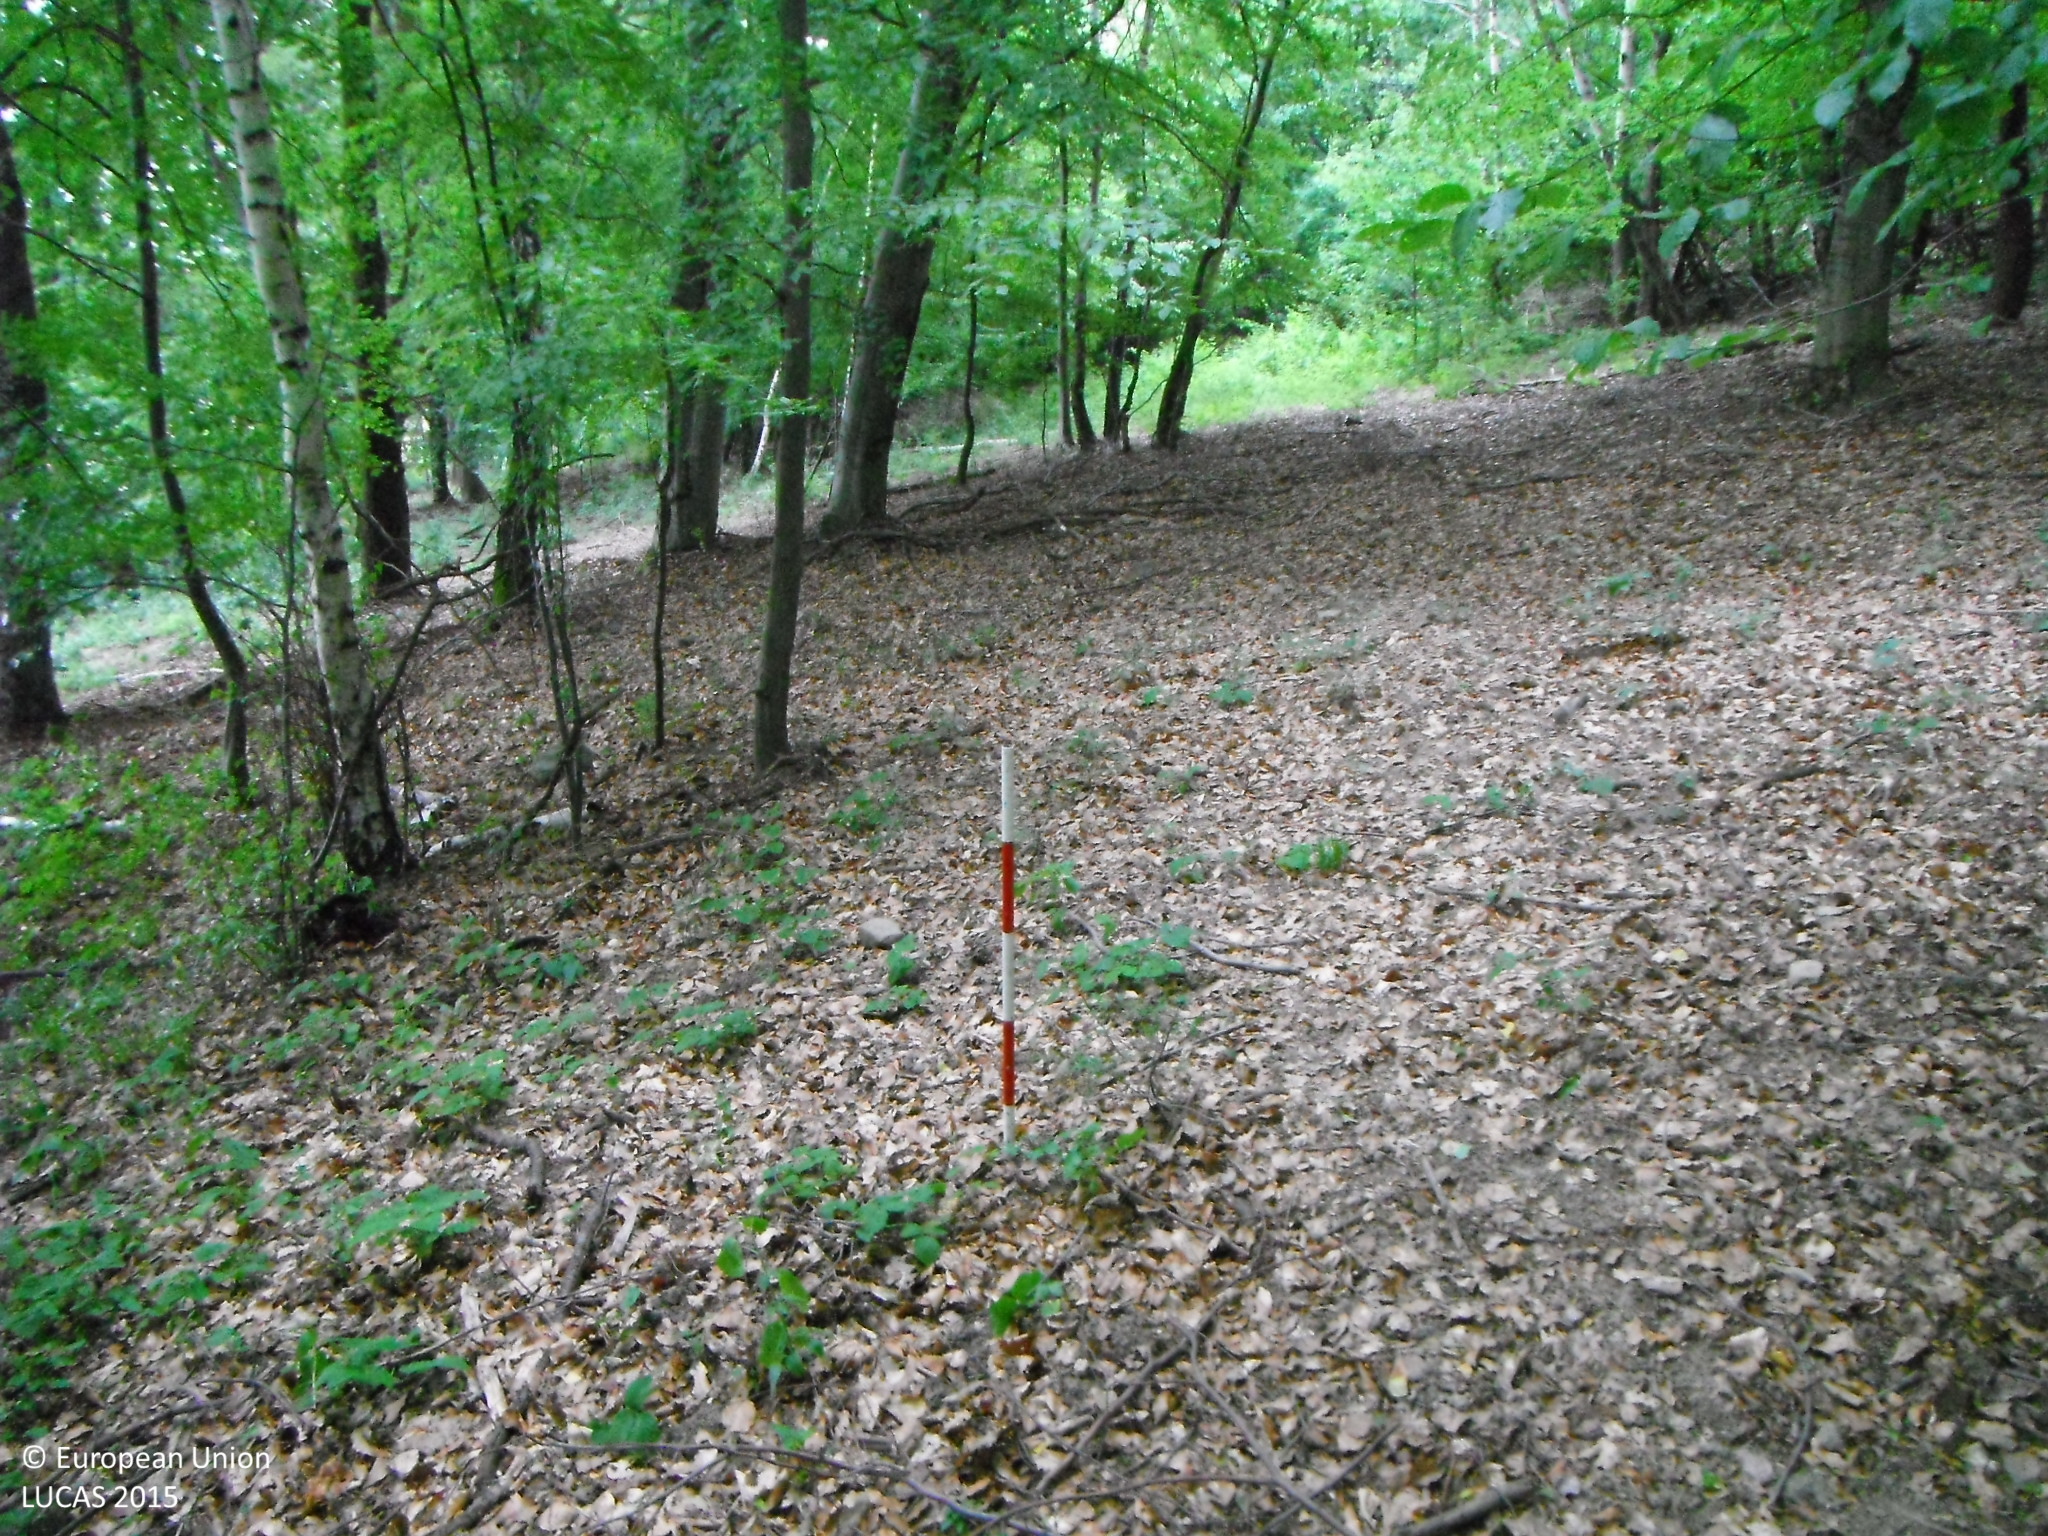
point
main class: Woodland
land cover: Broadleaved woodland
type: mesophytic deciduous forest
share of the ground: > 75 %
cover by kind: broadleaved forest trees 100 %
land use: Forestry
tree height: > 5 m
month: July
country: SK
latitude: 48.3307
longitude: 18.9358
